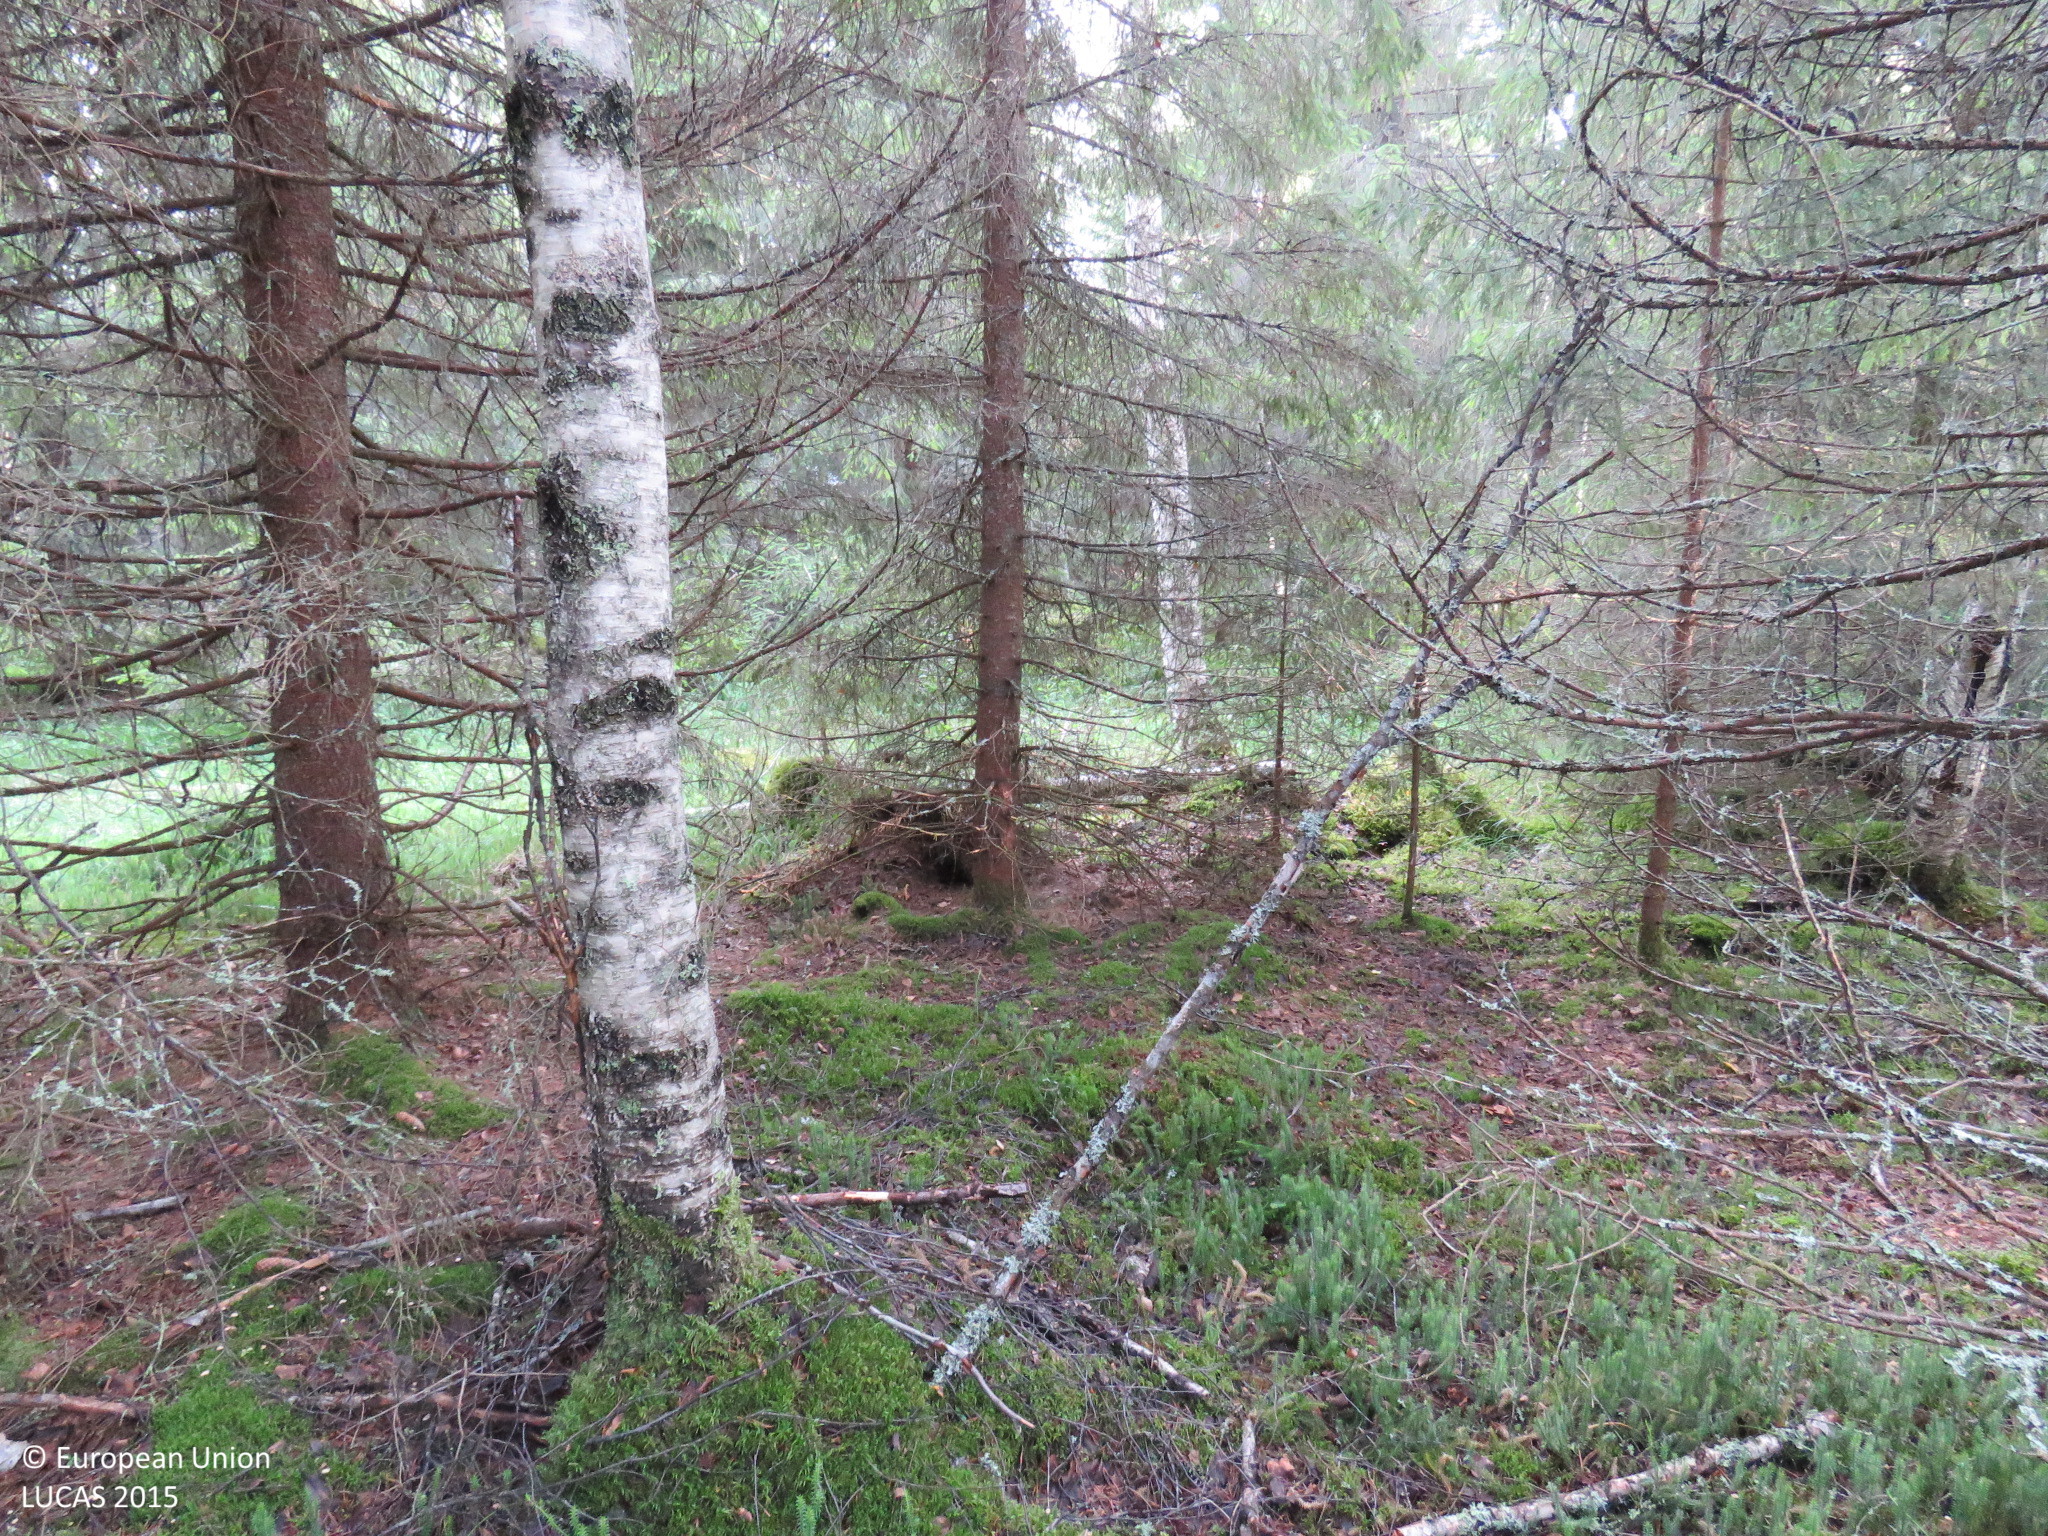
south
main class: Woodland
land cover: Spruce dominated mixed woodland
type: boreal forest
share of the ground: > 75 %
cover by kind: coniferous forest trees 60 %, broadleaved forest trees 25 %, shrubs 10 %, lichens and mosses 5 %
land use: Forestry
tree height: > 5 m
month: July
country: FI
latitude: 64.6028
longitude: 26.3033
